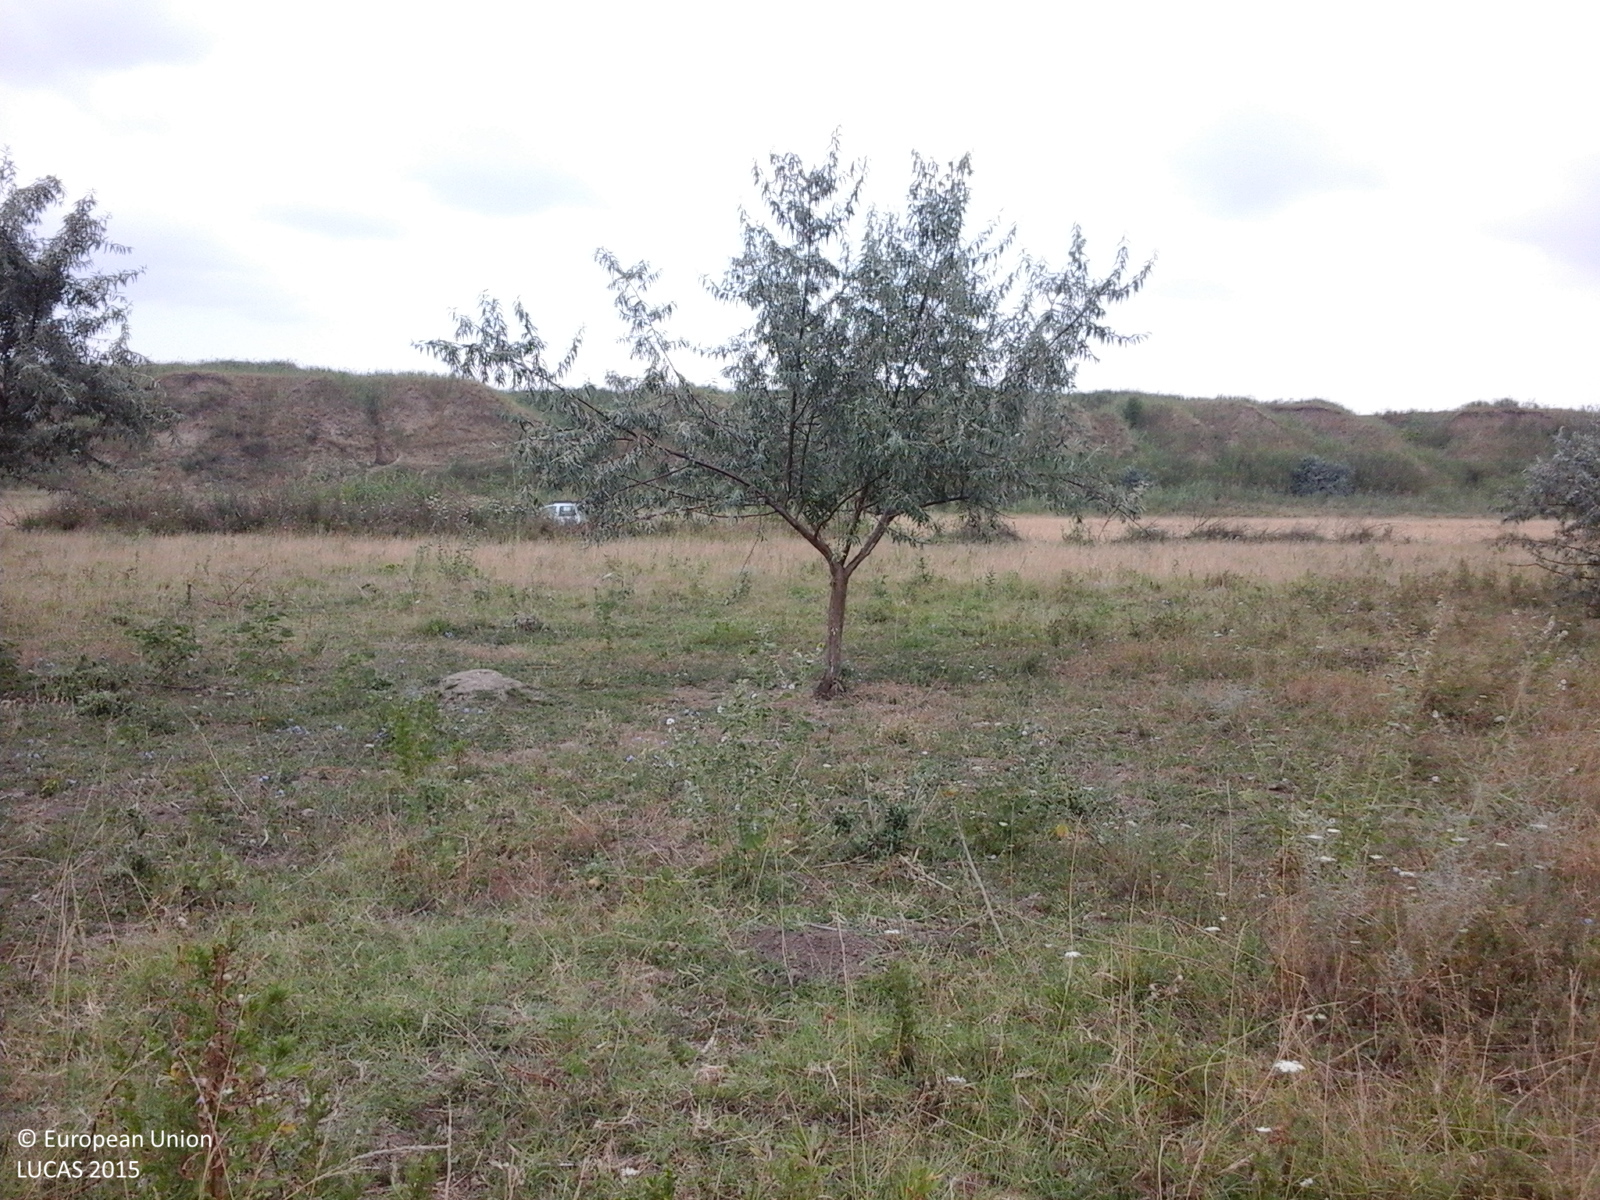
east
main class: Grassland
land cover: Grassland with sparse tree/shrub cover
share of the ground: > 75 %
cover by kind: herbaceous plants 85 %, shrubs 10 %, broadleaved forest trees 5 %
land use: Semi-natural and natural areas not in use
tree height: > 5 m
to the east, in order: Grassland with sparse tree/shrub cover; Grassland without tree/shrub cover; Shruby margins; Tracks; Grassland without tree/shrub cover; Inland marshes; Tracks; Common wheat
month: July
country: RO
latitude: 45.0645
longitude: 28.2180
